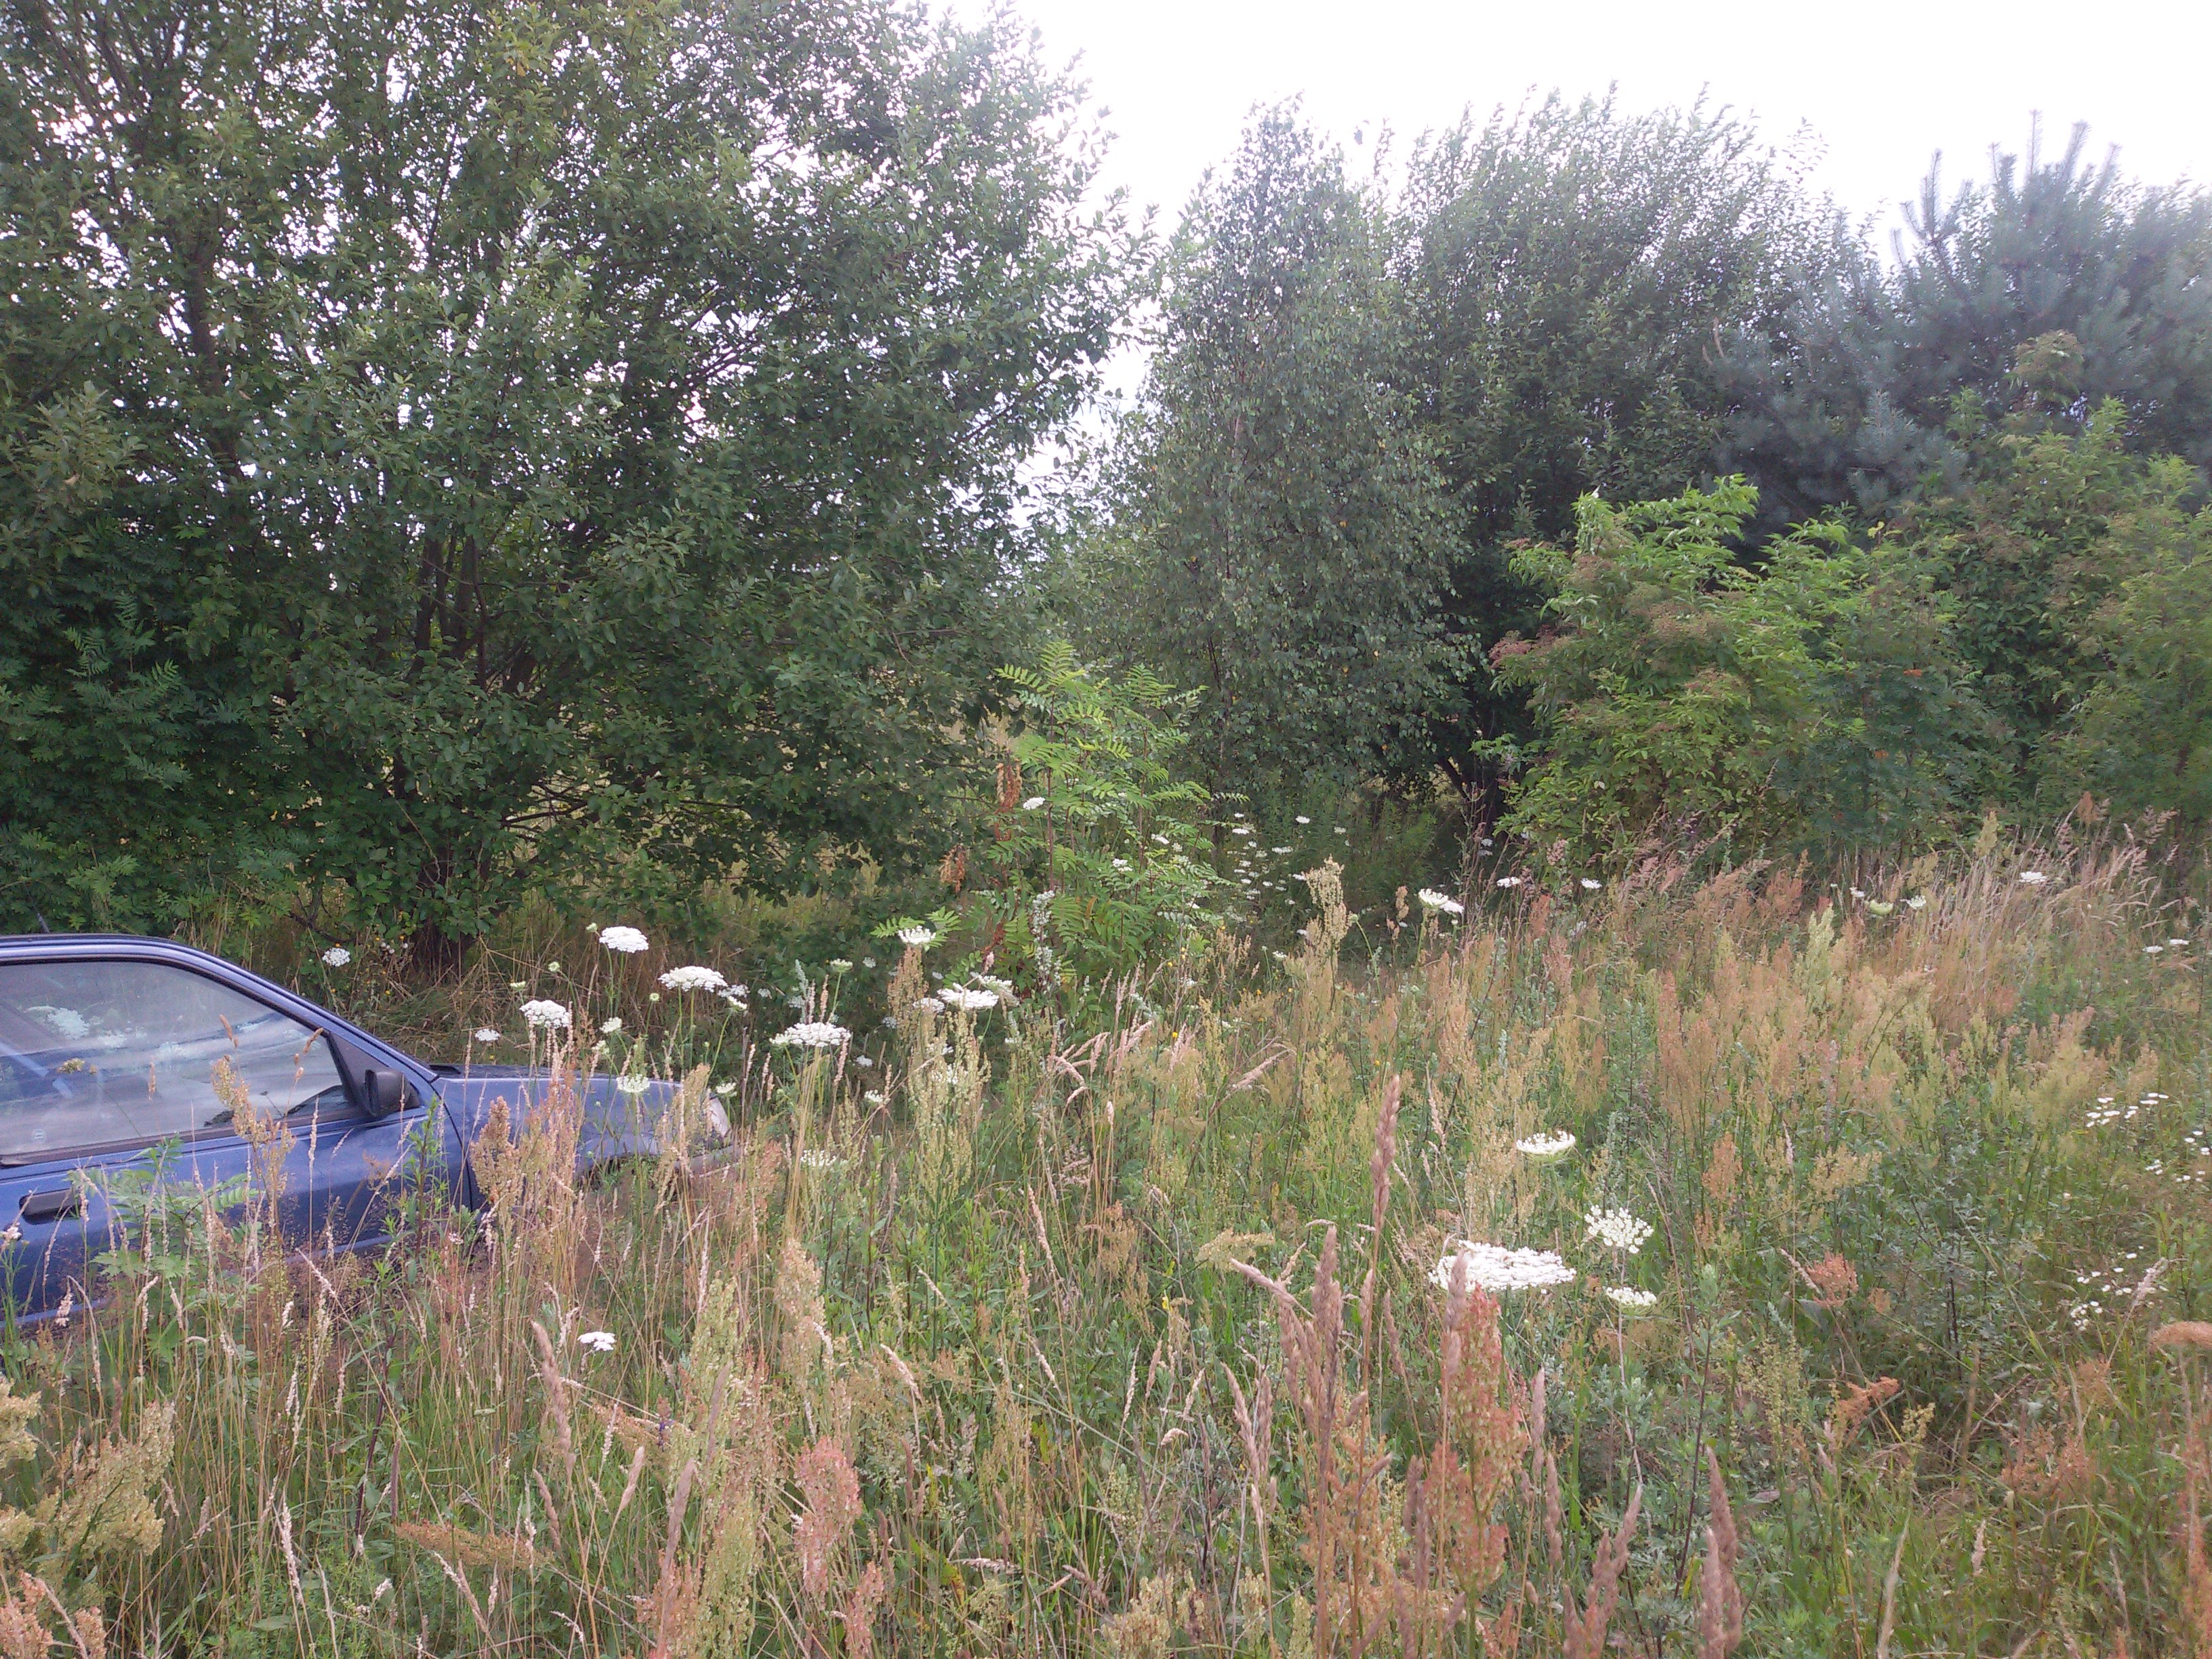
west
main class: Cropland
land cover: Rye
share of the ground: > 75 %
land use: Agriculture (excluding fallow land and kitchen gardens)
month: July
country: PL
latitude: 53.5341
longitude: 15.7827
